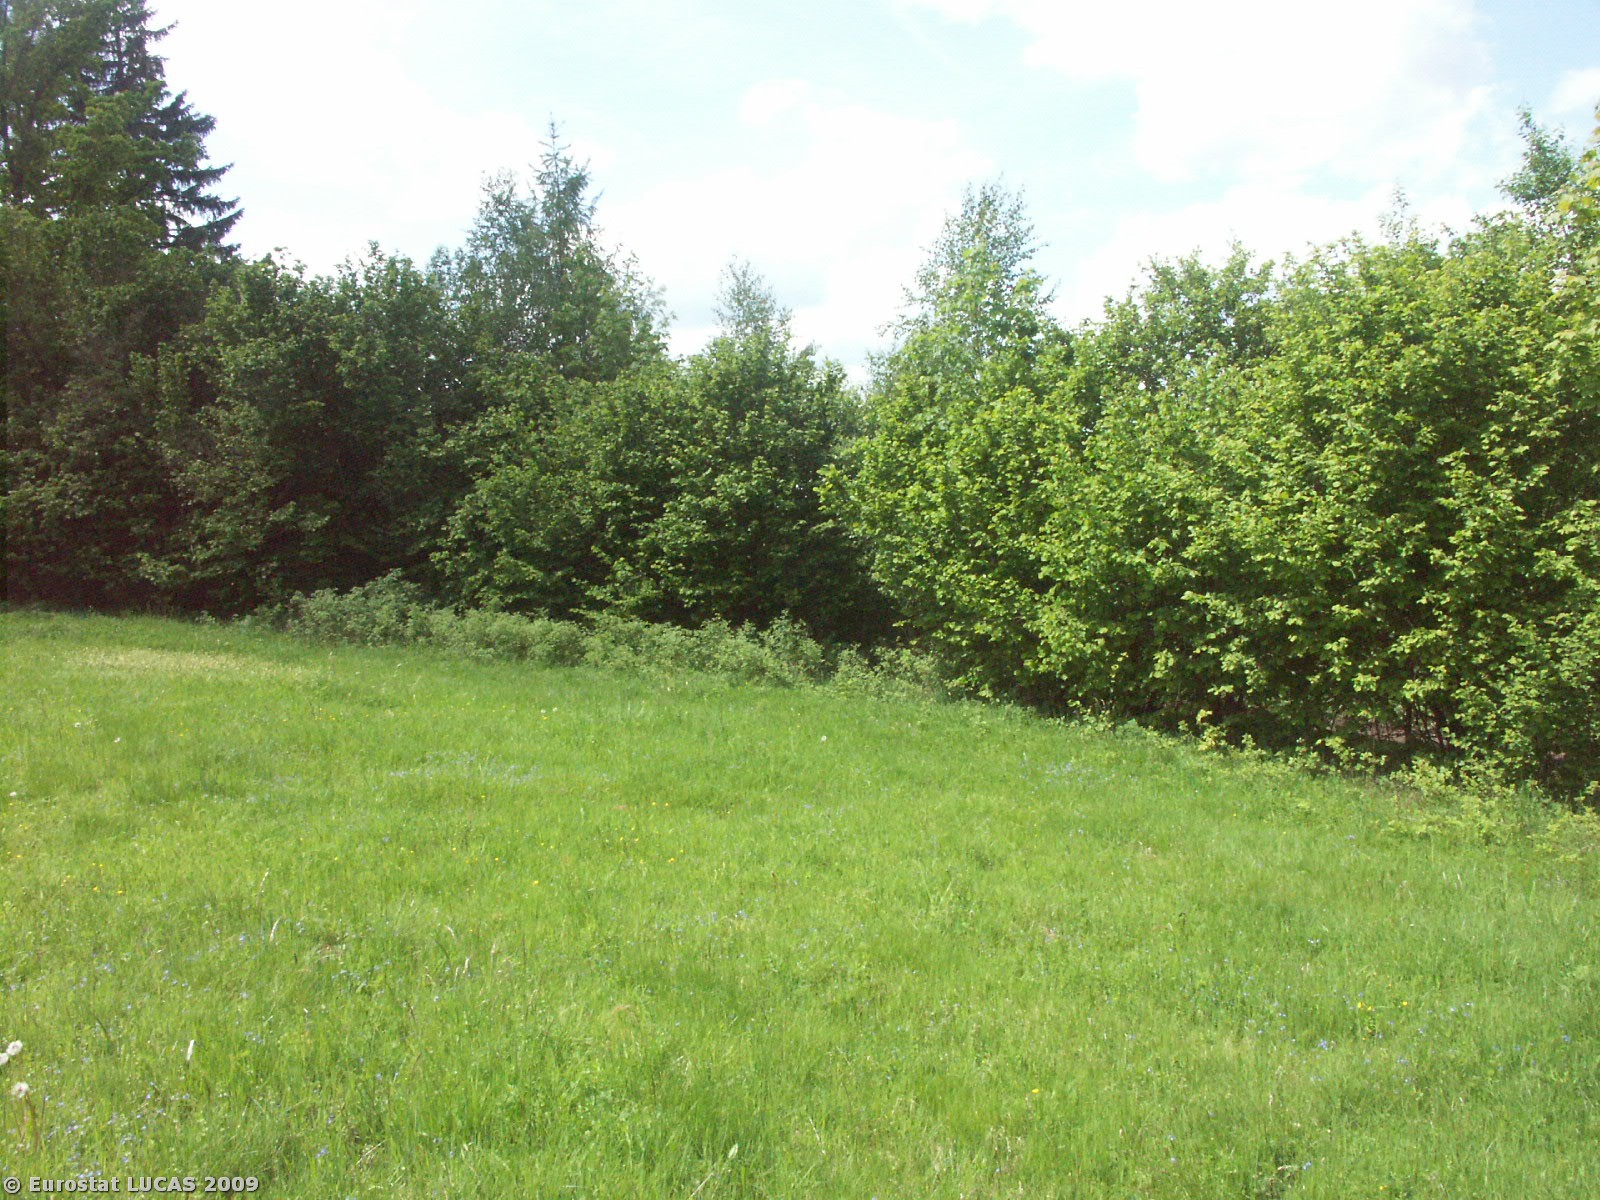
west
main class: Grassland
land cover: Grassland without tree/shrub cover
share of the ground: > 75 %
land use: Agriculture (excluding fallow land and kitchen gardens)
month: May
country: CZ
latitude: 48.7219
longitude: 14.6092
